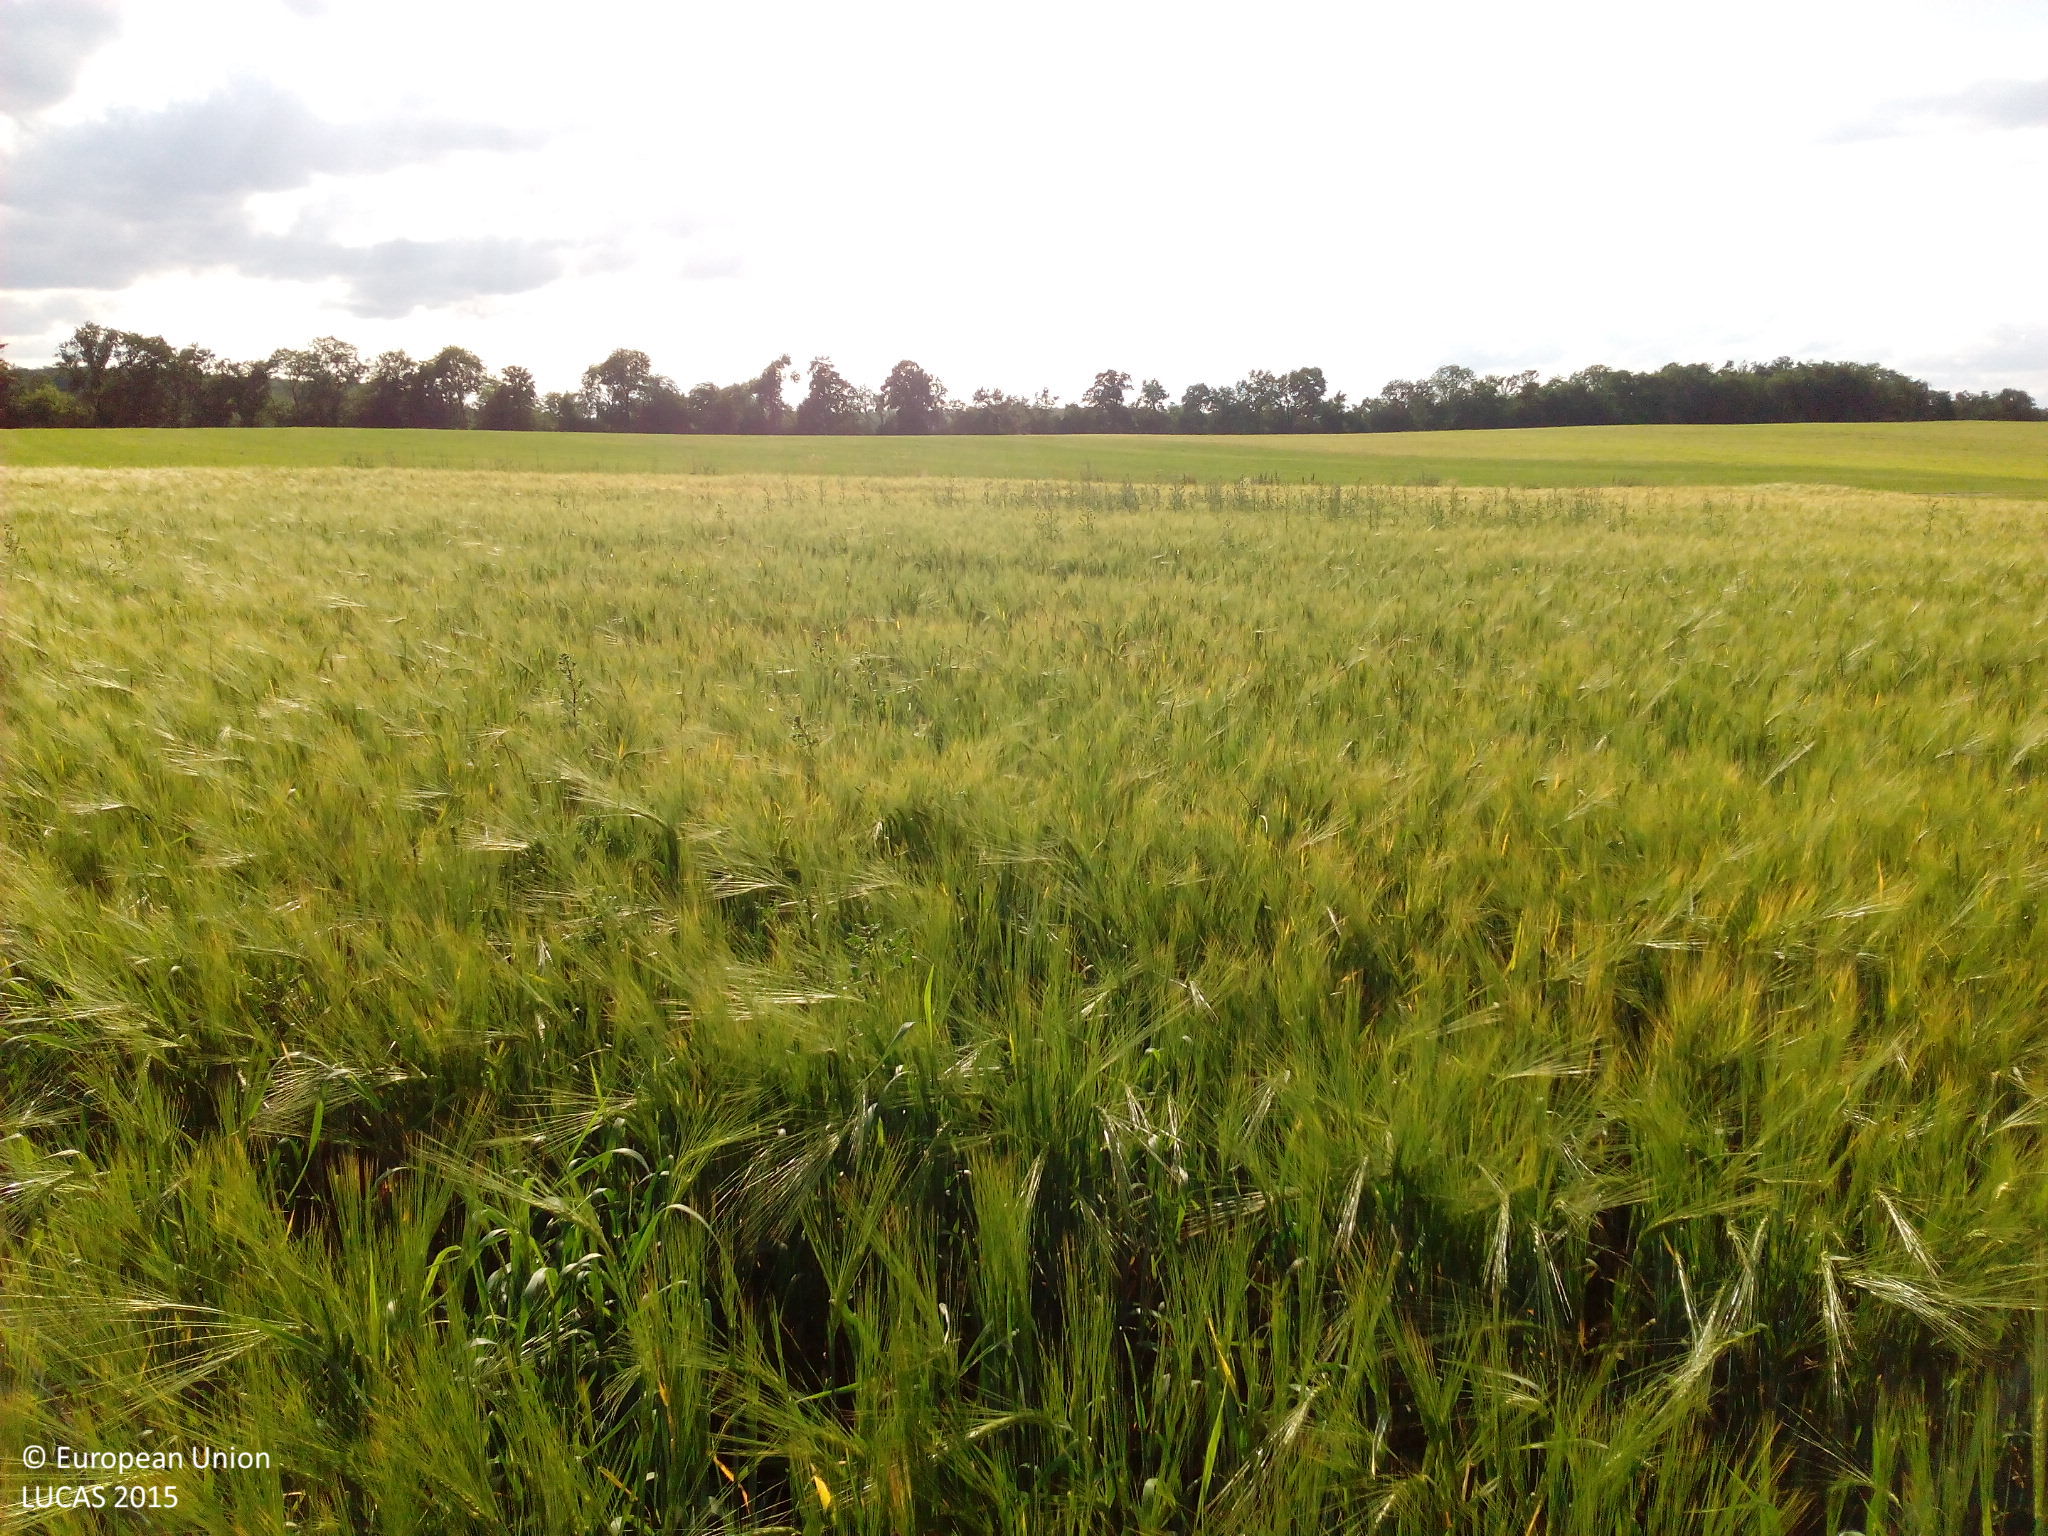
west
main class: Cropland
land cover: Barley
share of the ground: > 75 %
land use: Agriculture (excluding fallow land and kitchen gardens)
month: July
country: DE
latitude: 48.6373
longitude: 9.8508
